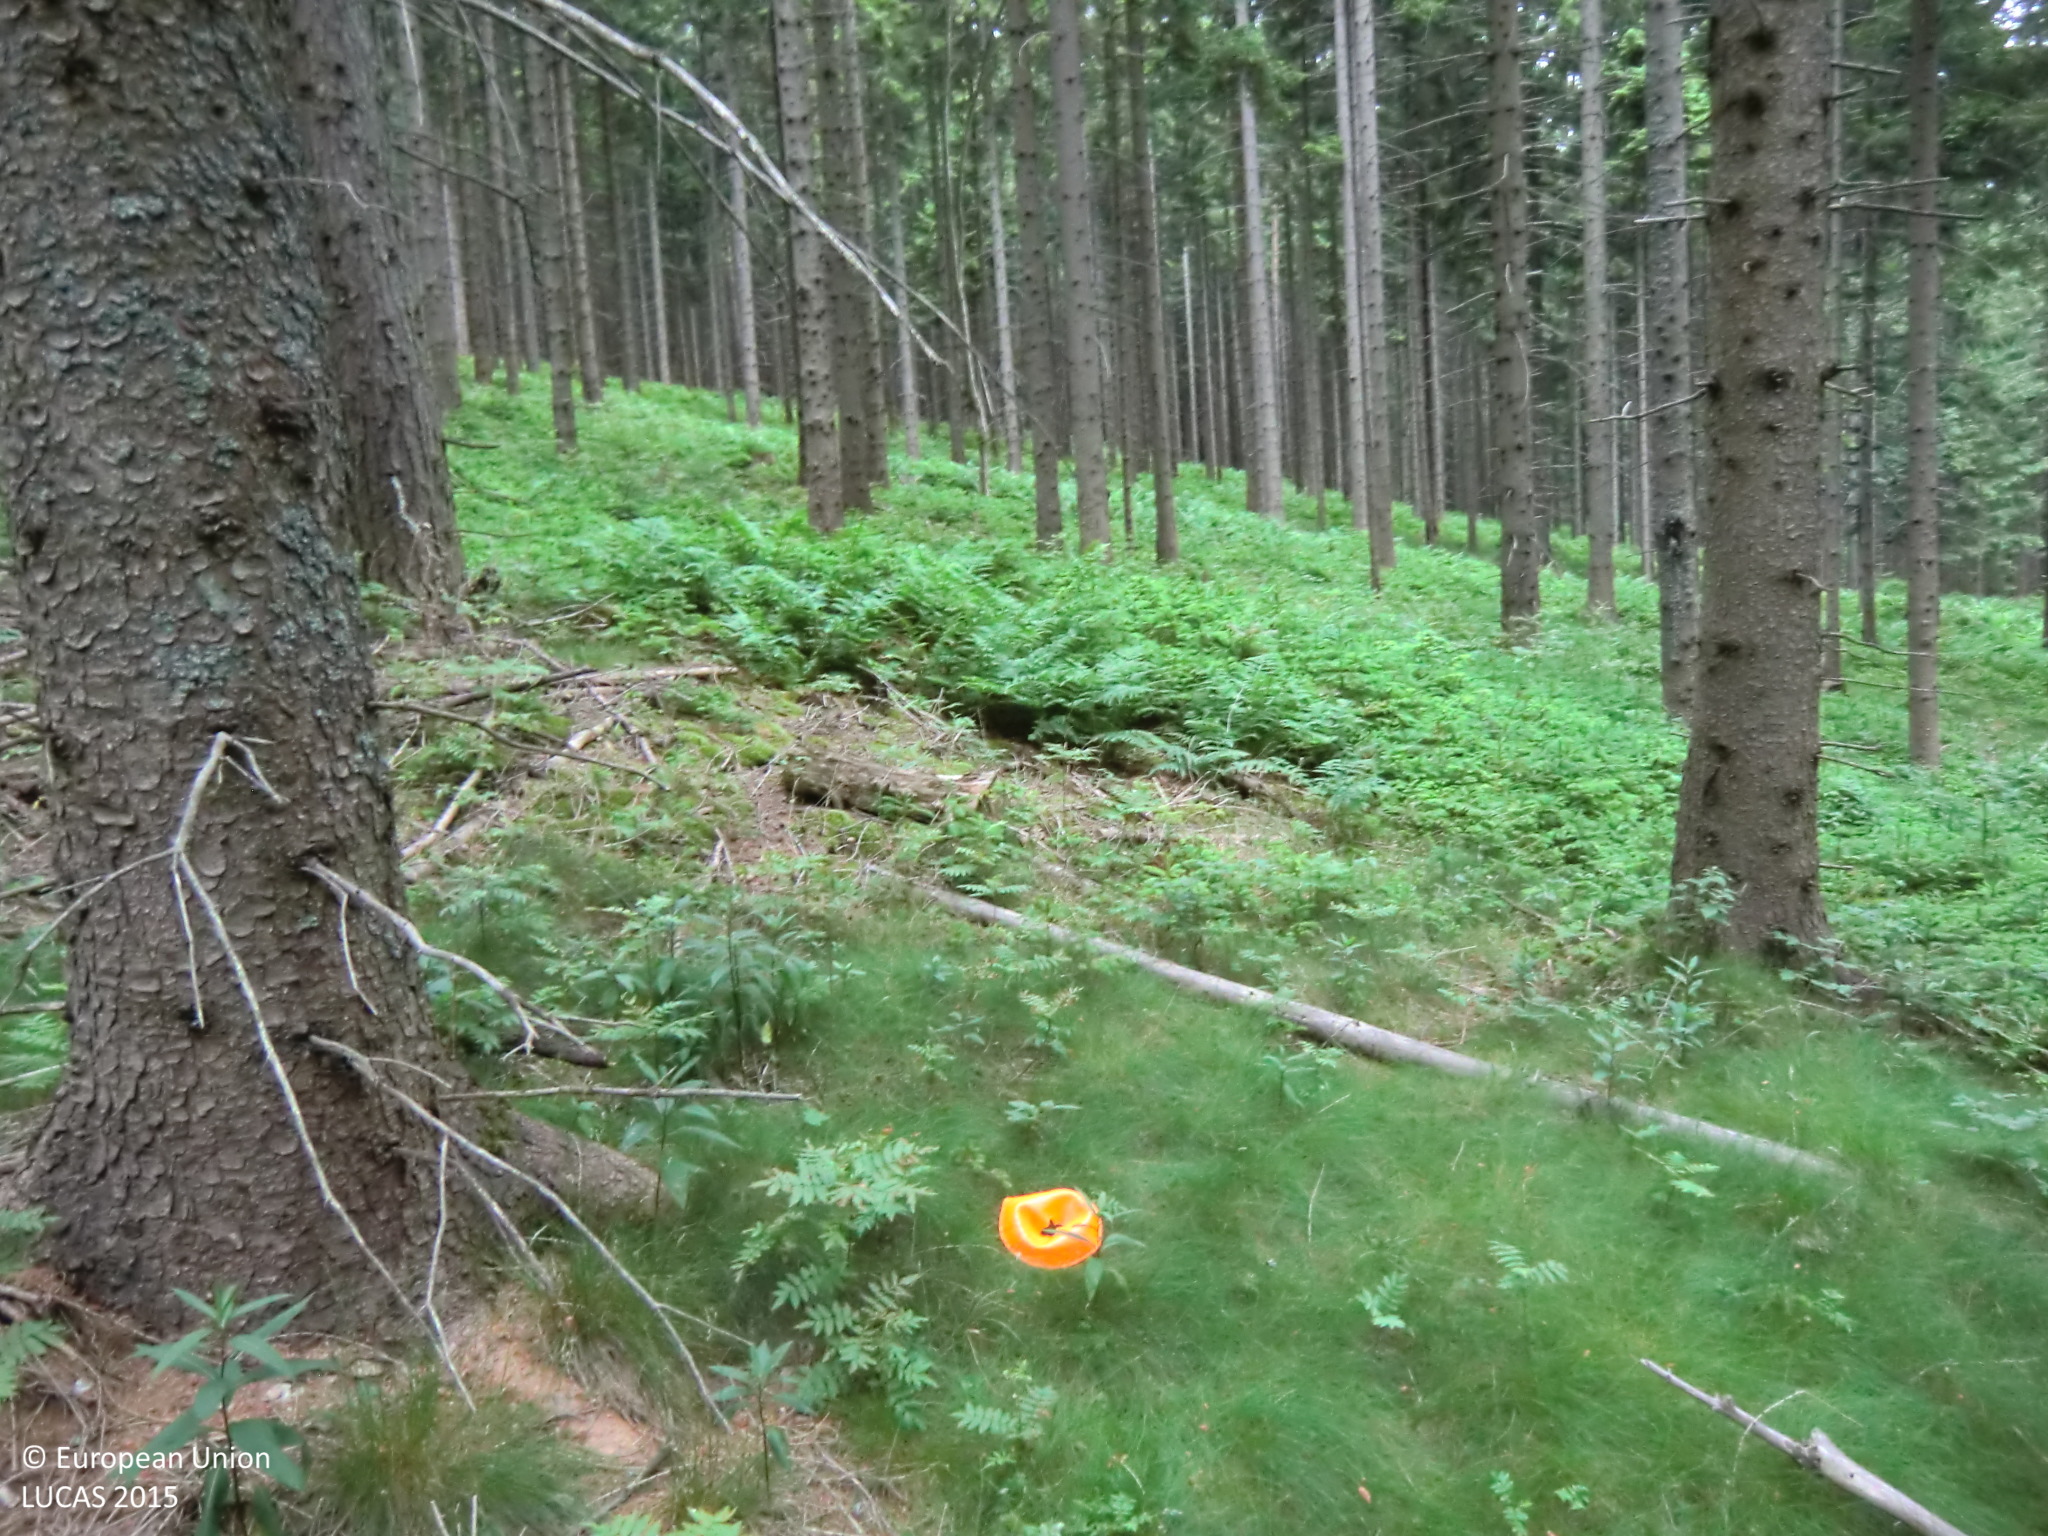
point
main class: Woodland
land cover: Spruce dominated coniferous woodland
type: alpine coniferous forest
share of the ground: > 75 %
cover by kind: coniferous forest trees 80 %, shrubs 10 %, herbaceous plants 10 %
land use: Forestry
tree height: > 5 m
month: June
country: AT
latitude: 47.2974
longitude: 15.7538
